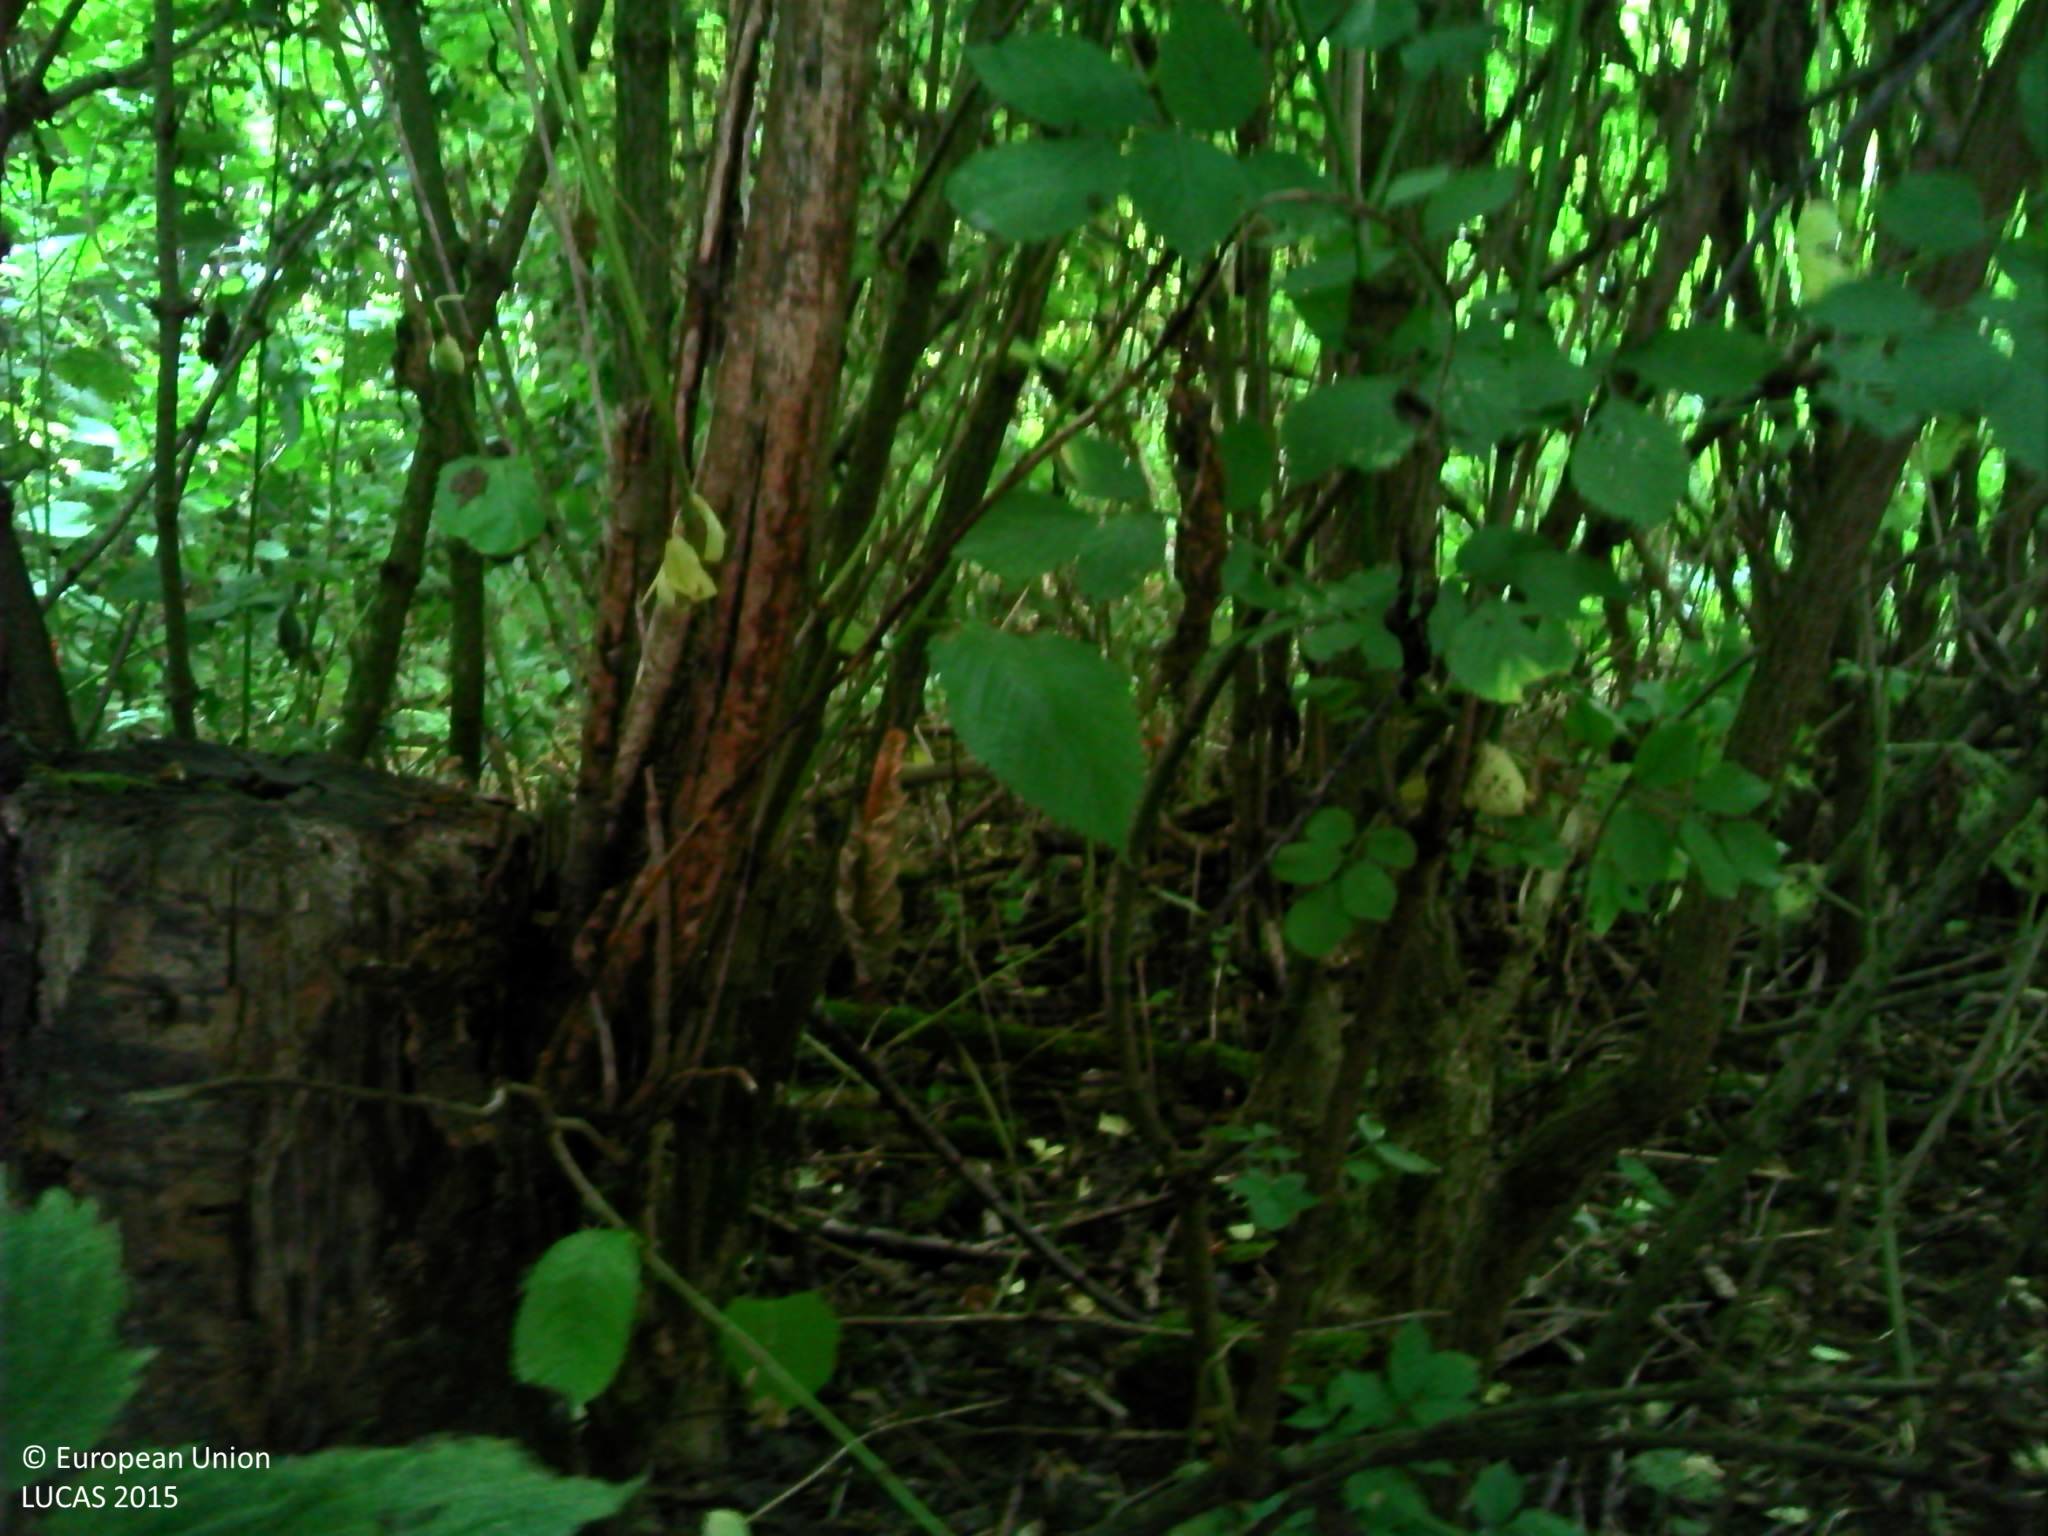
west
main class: Woodland
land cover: Broadleaved woodland
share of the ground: > 75 %
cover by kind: broadleaved forest trees 60 %, shrubs 20 %, herbaceous plants 5 %
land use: Semi-natural and natural areas not in use
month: August
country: FR
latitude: 50.8992
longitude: 2.0360
